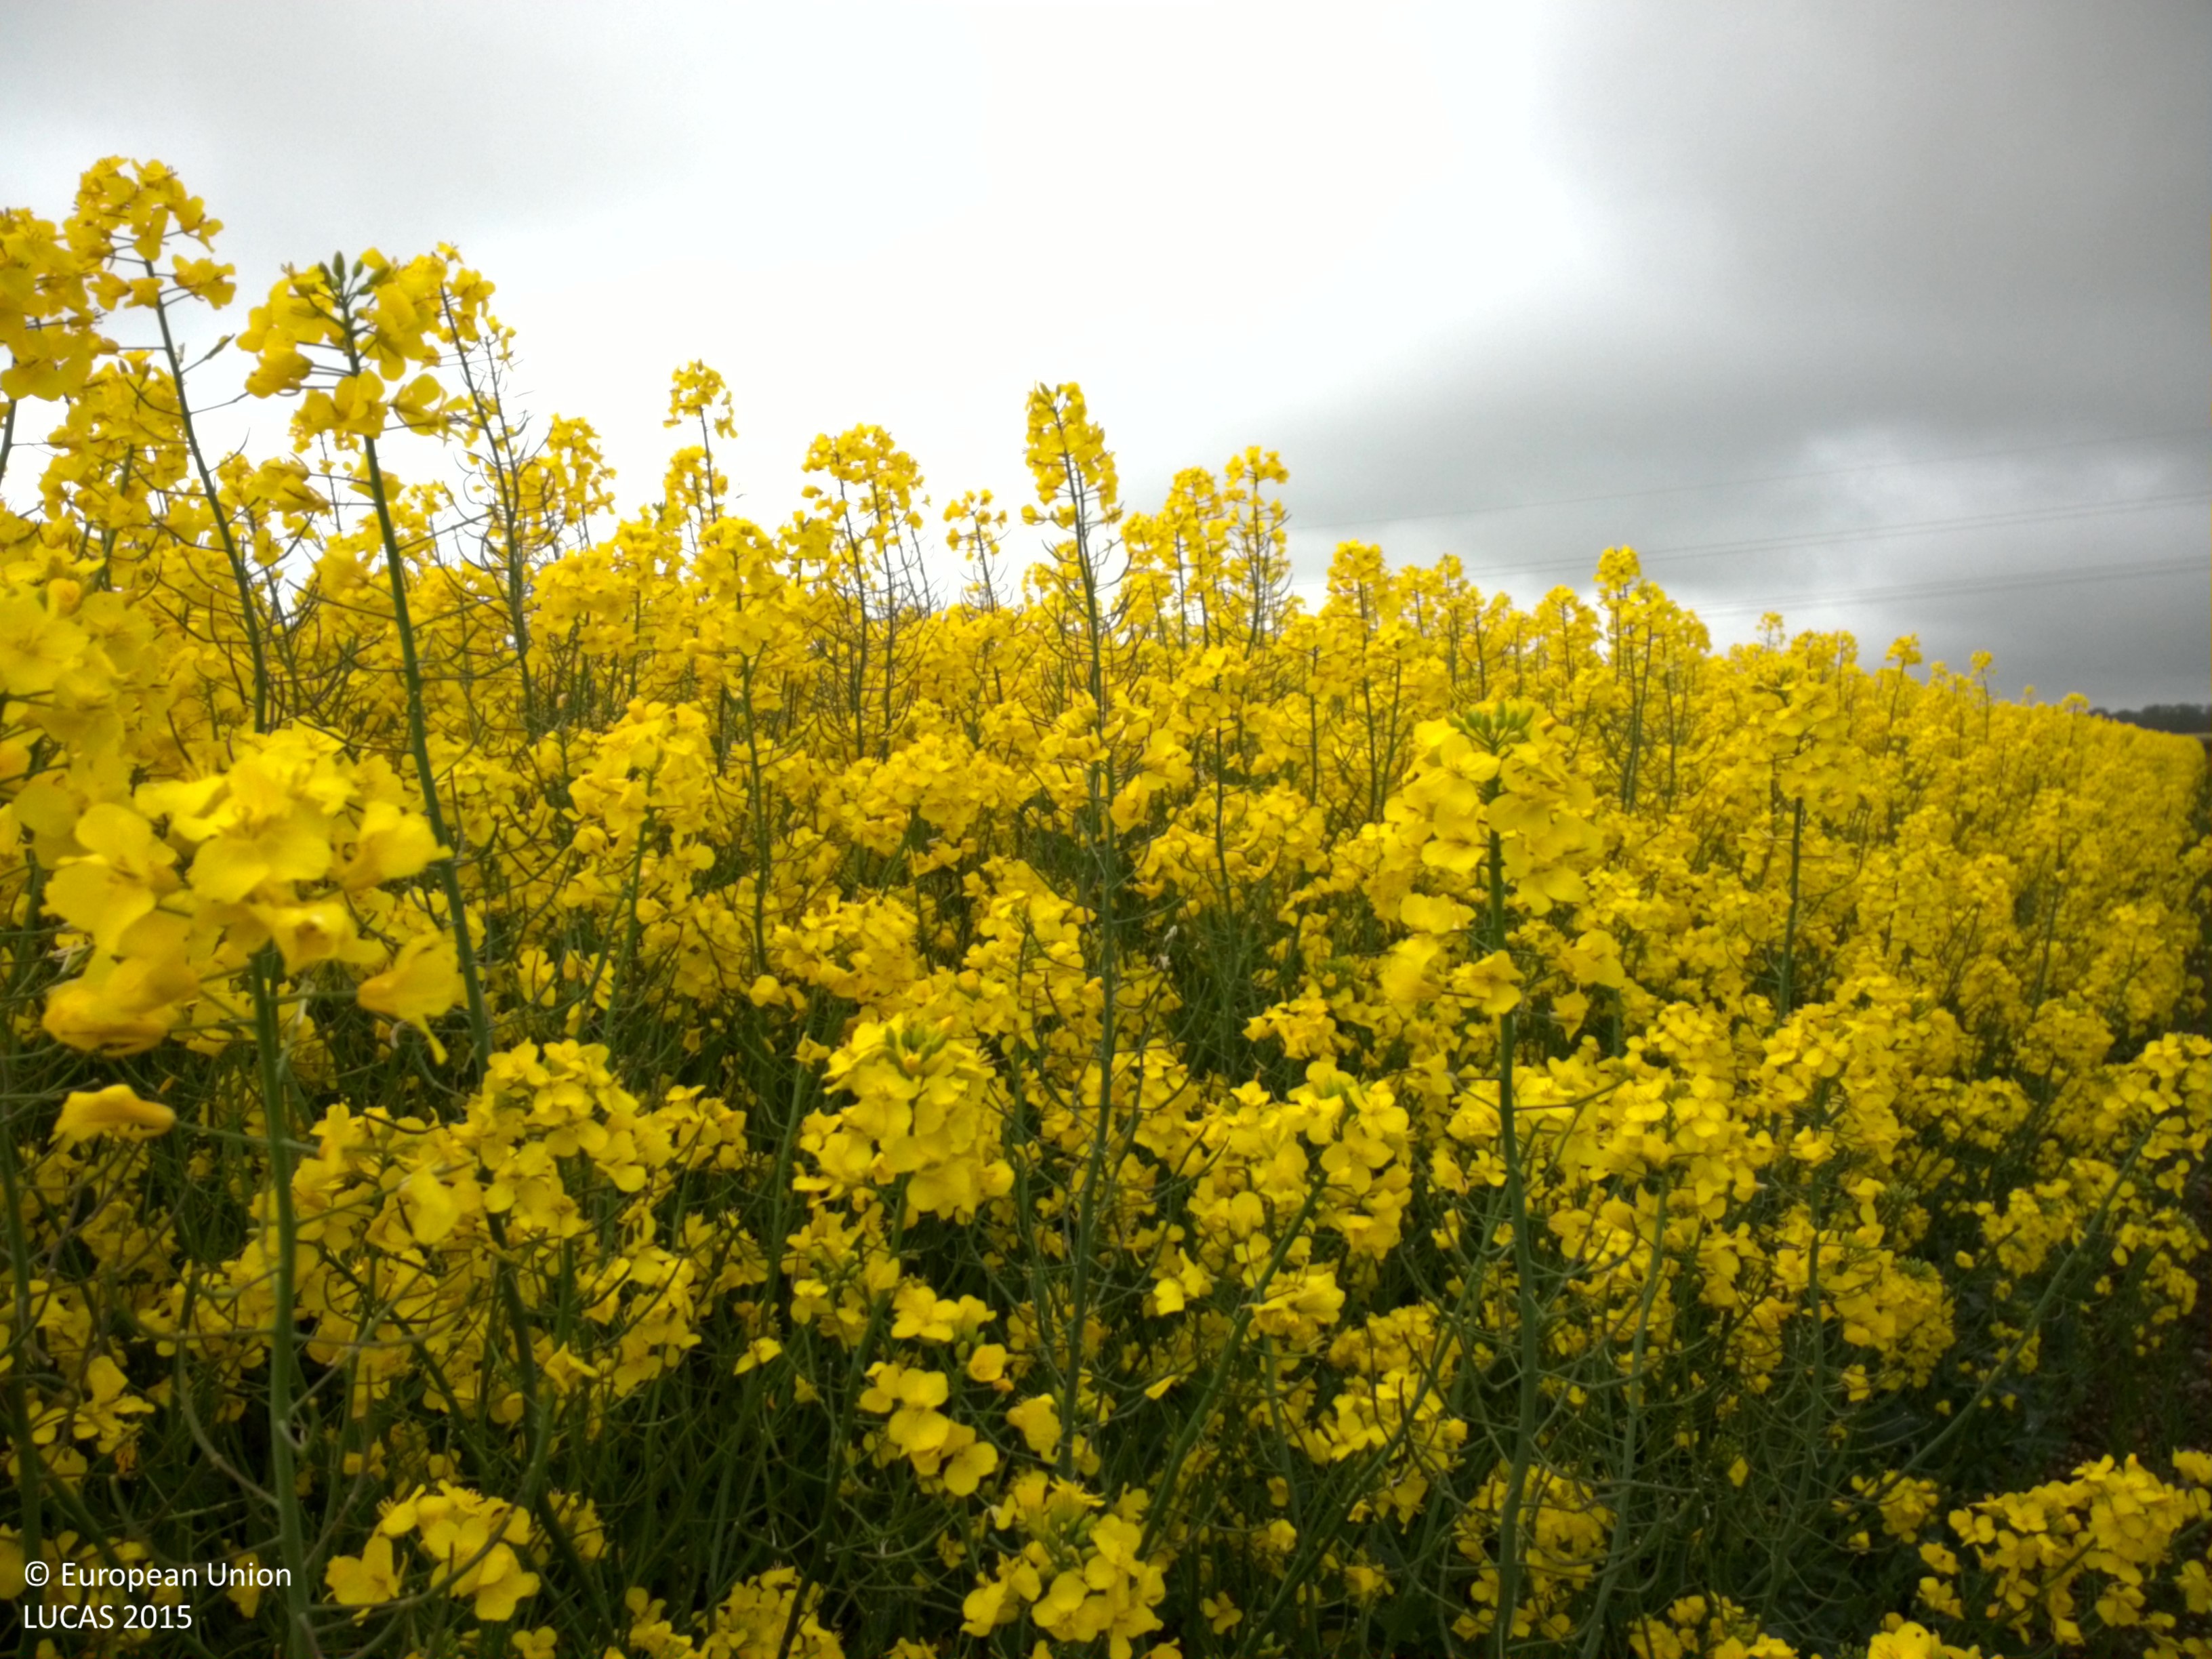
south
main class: Cropland
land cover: Rape and turnip rape
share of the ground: > 75 %
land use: Agriculture (excluding fallow land and kitchen gardens)
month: May
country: SE
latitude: 55.7537
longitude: 13.1367
